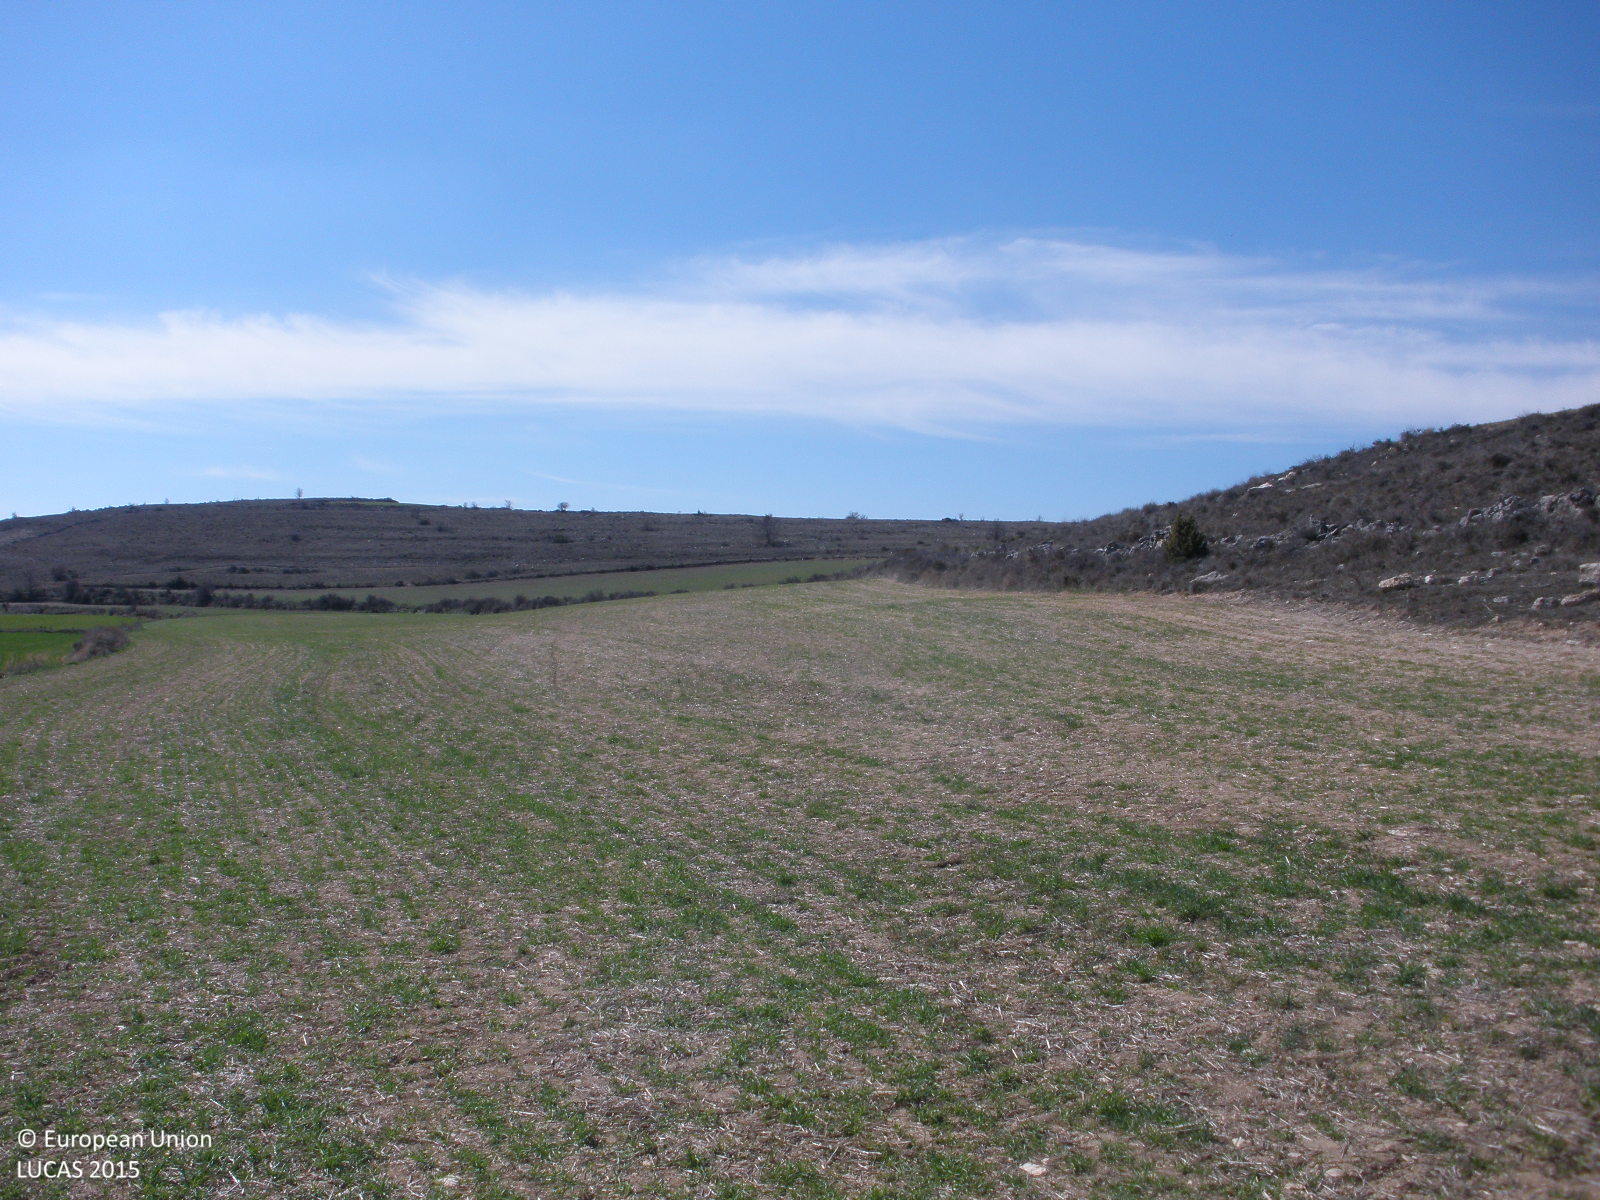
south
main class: Cropland
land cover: Barley
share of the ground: 25 - 50 %
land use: Agriculture (excluding fallow land and kitchen gardens)
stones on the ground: 10 - 25 %
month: April
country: ES
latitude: 40.8540
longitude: -1.1310
